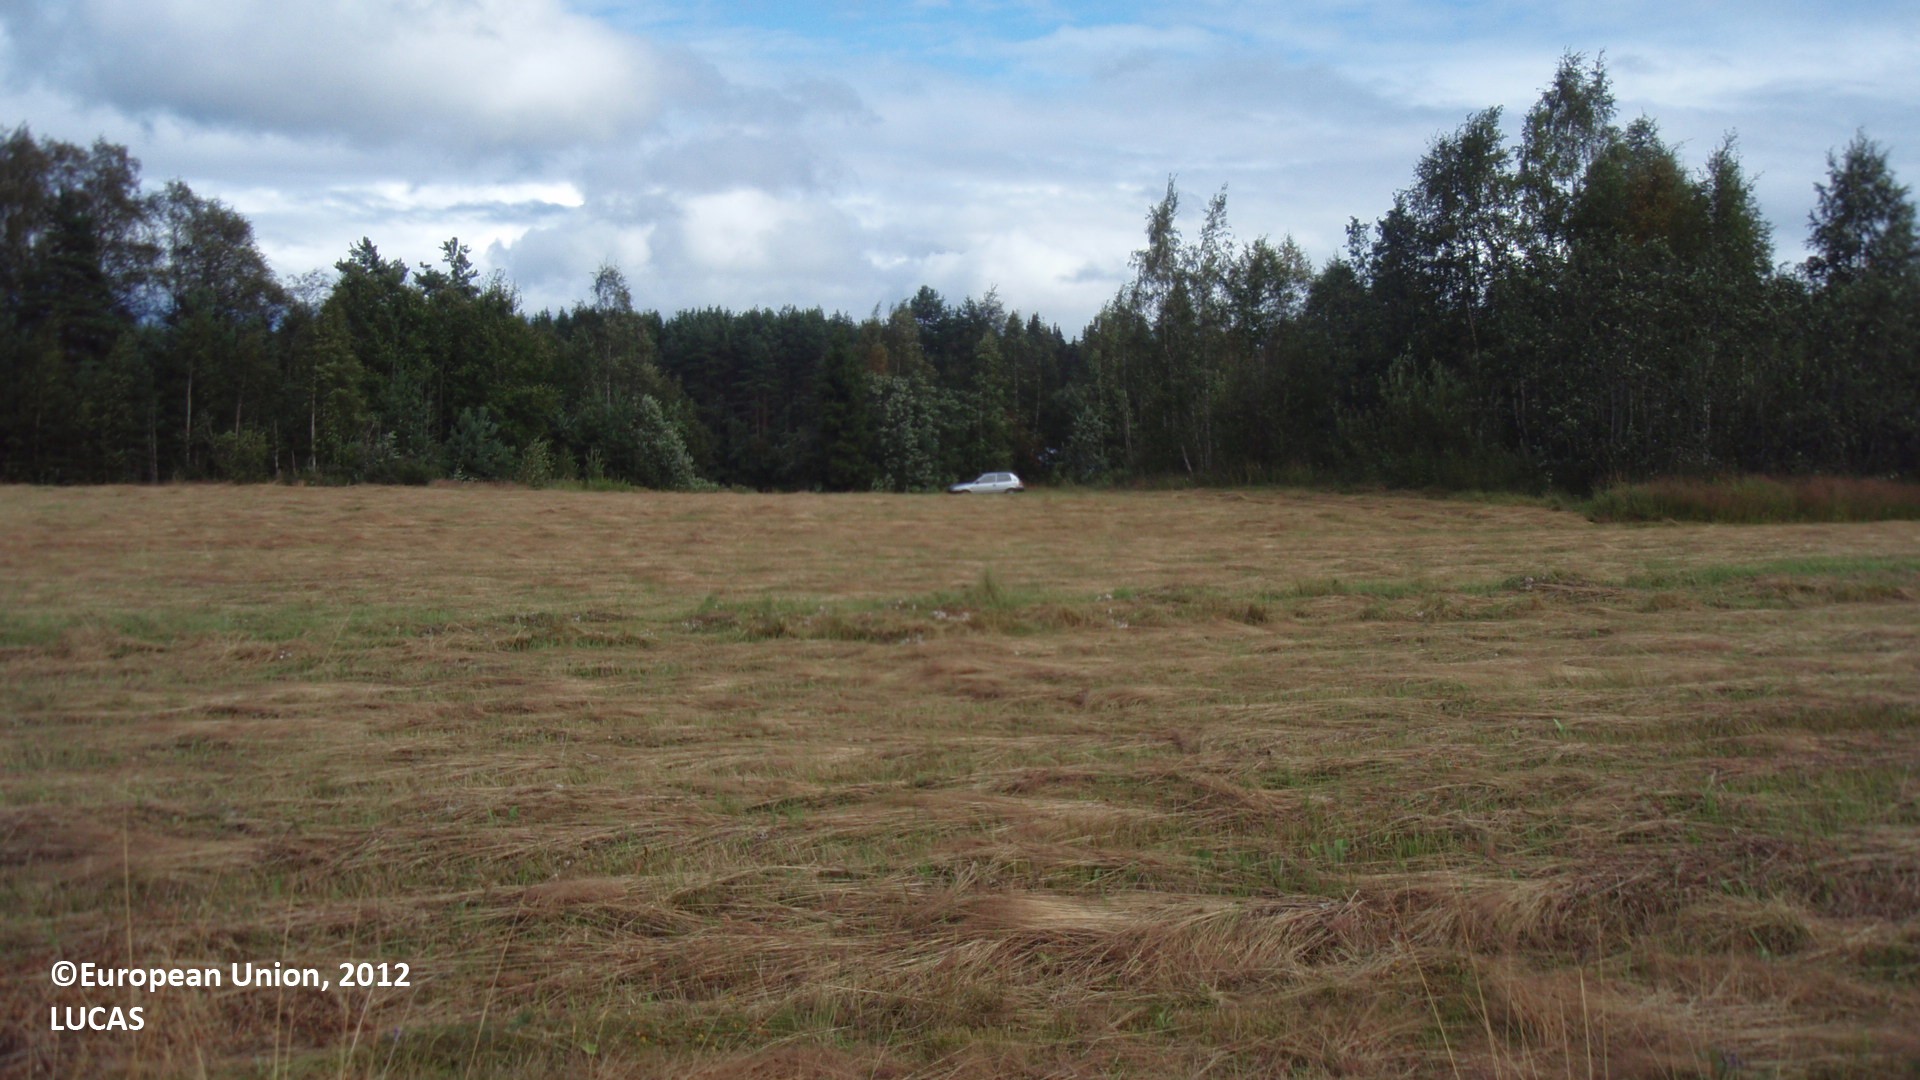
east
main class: Cropland
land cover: Common wheat
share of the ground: > 75 %
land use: Agriculture (excluding fallow land and kitchen gardens)
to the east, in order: Common wheat; Ditches and canals; Mixed cereals for fodder; Pine dominated mixed woodland; Grass margins; Paved roads, cycling and walking lanes; Grass margins; Broadleaved woodland; Ditches and canals; Broadleaved woodland; Oats
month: August
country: FI
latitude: 61.0766
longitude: 27.0151
